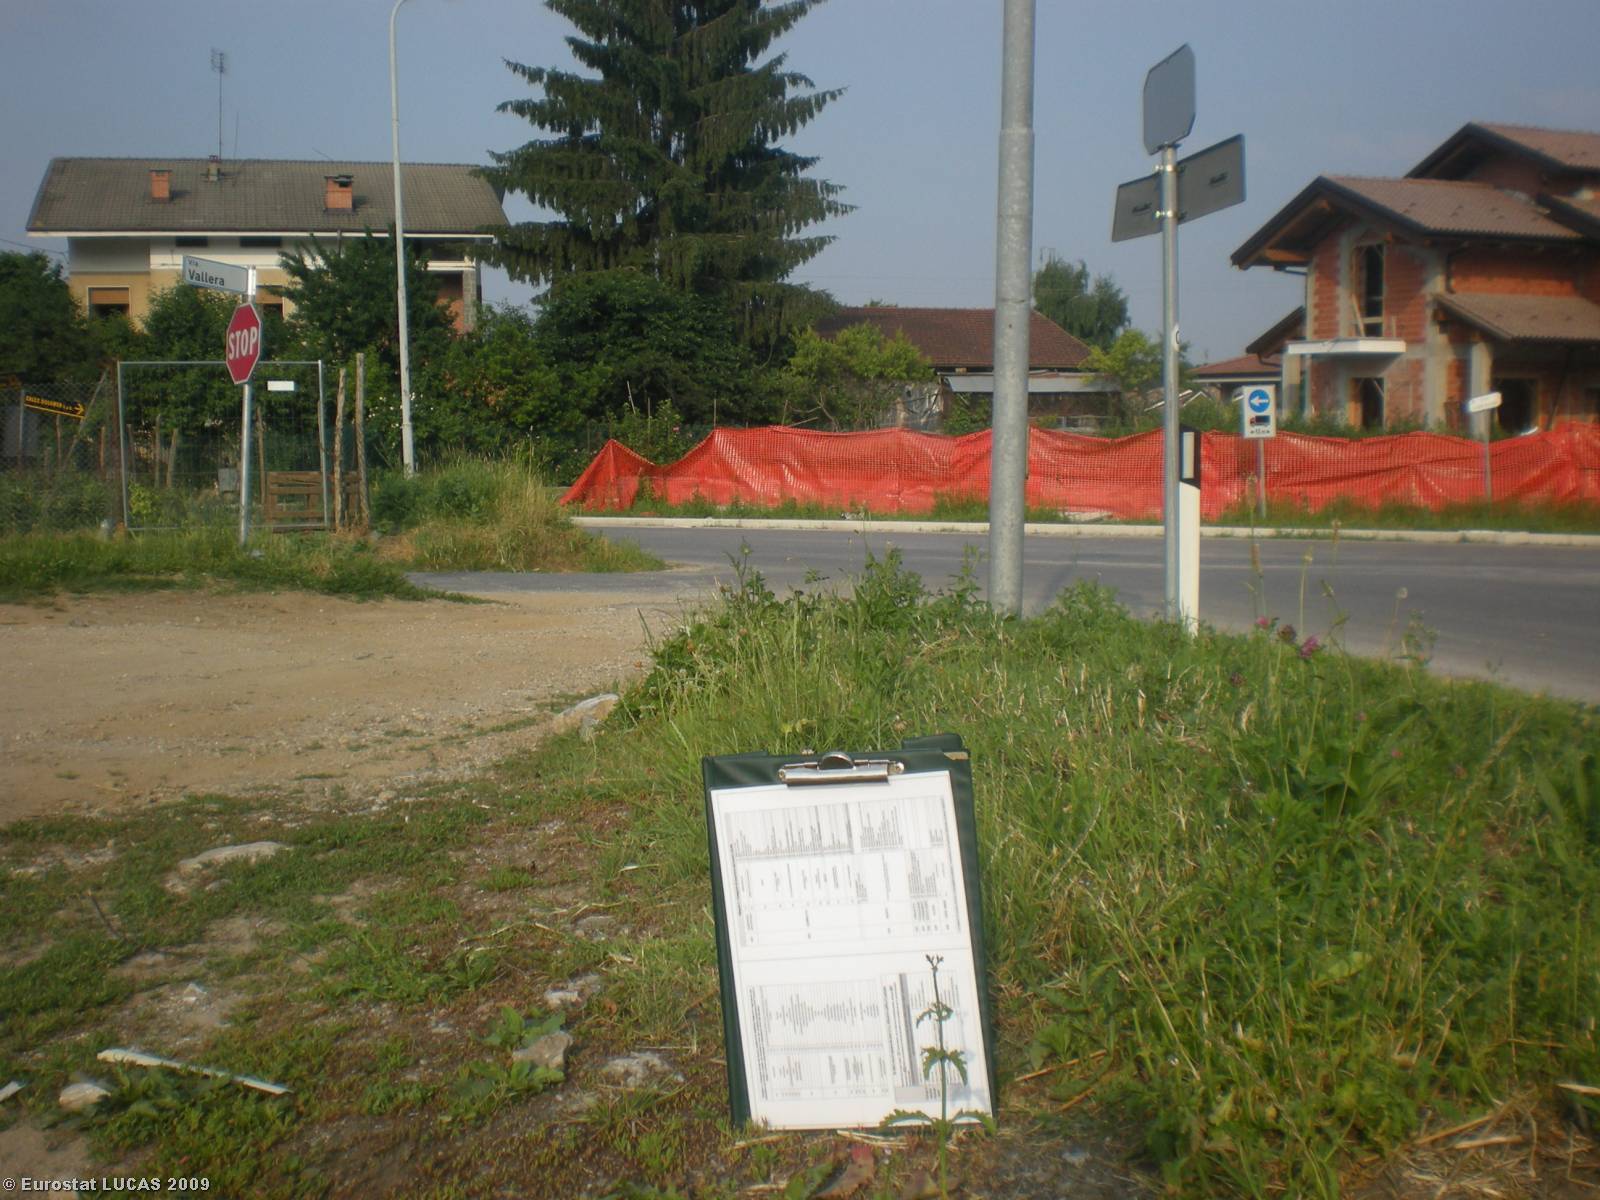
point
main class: Bare land
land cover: Bare land
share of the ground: > 75 %
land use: Residential
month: June
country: IT
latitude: 44.3910
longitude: 7.4319
